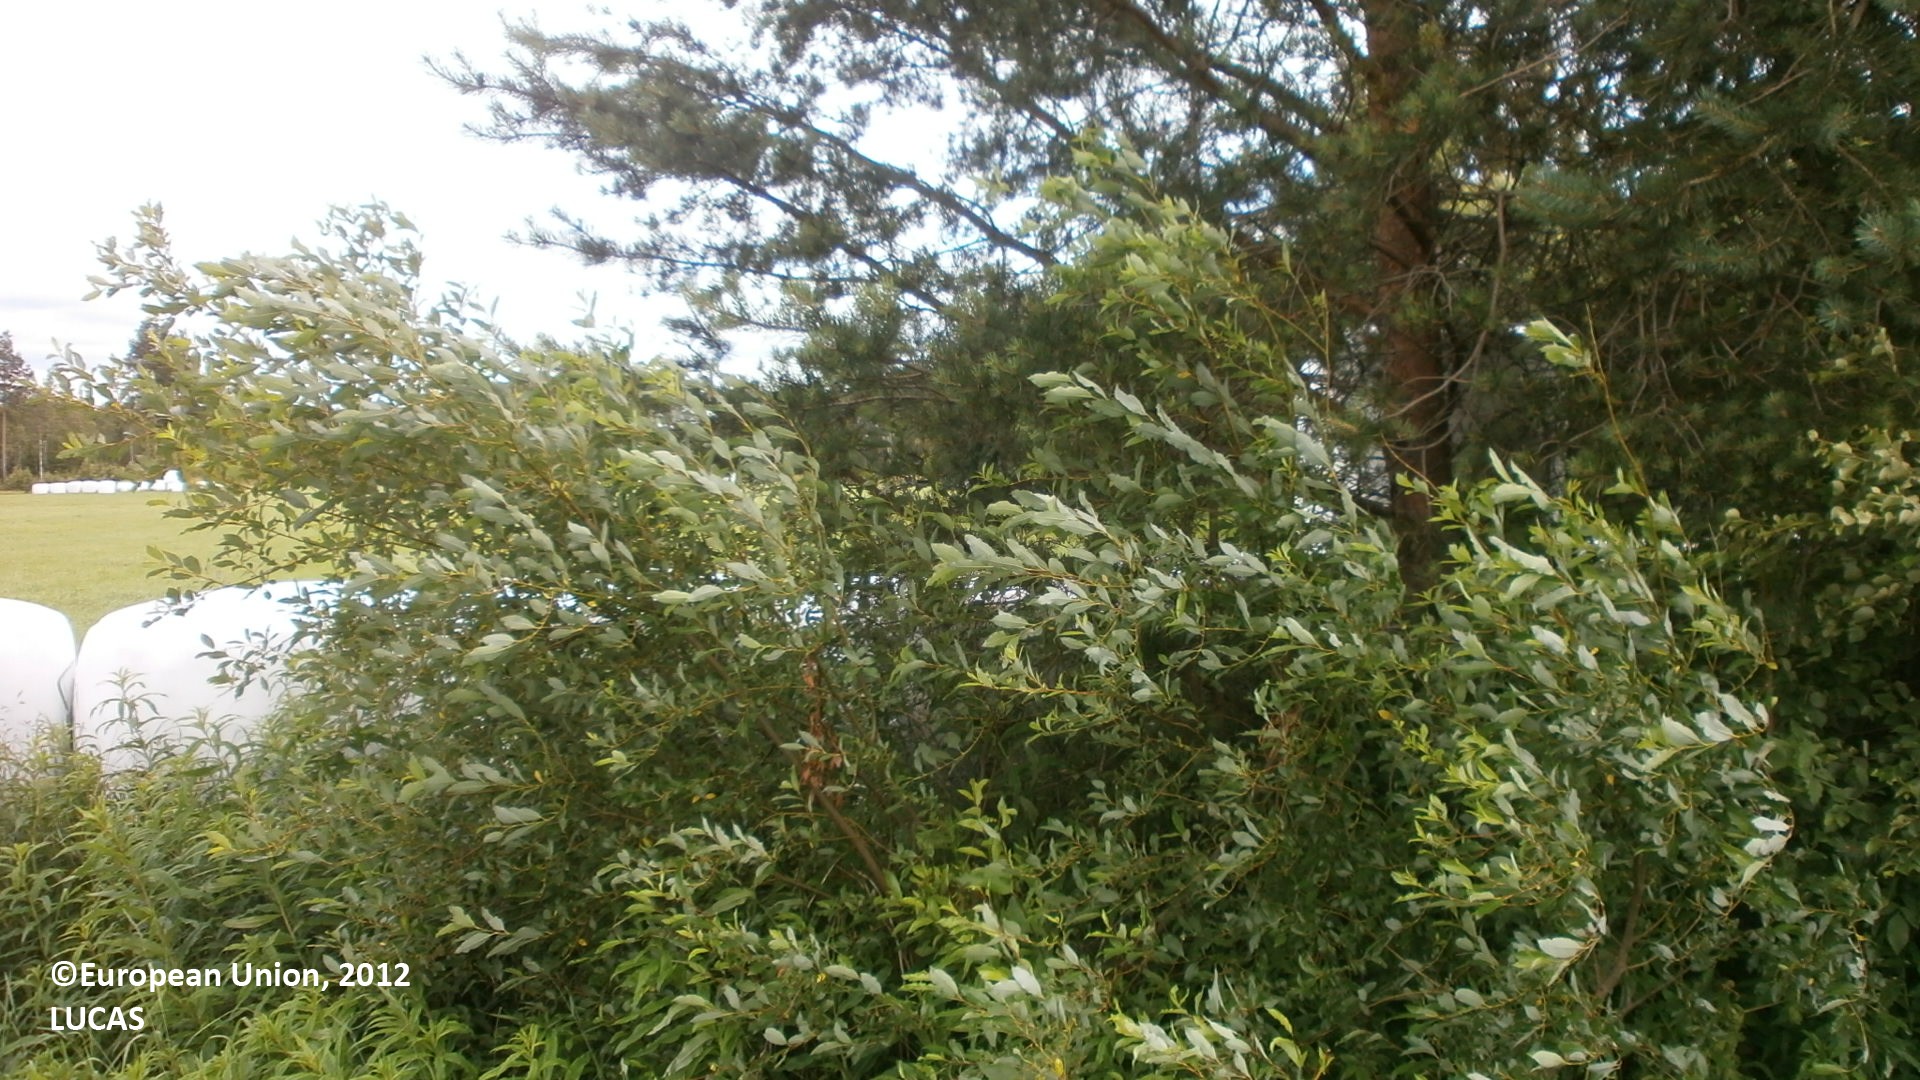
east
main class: Grassland
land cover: Spontaneously vegetated surfaces
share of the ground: > 75 %
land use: Road transport
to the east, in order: Spontaneously vegetated surfaces; Ditches and canals; Lines of trees; Temporary grasslands; Electric lines; Temporary grasslands; Electric lines; Temporary grasslands
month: July
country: FI
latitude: 63.9878
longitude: 24.2742
